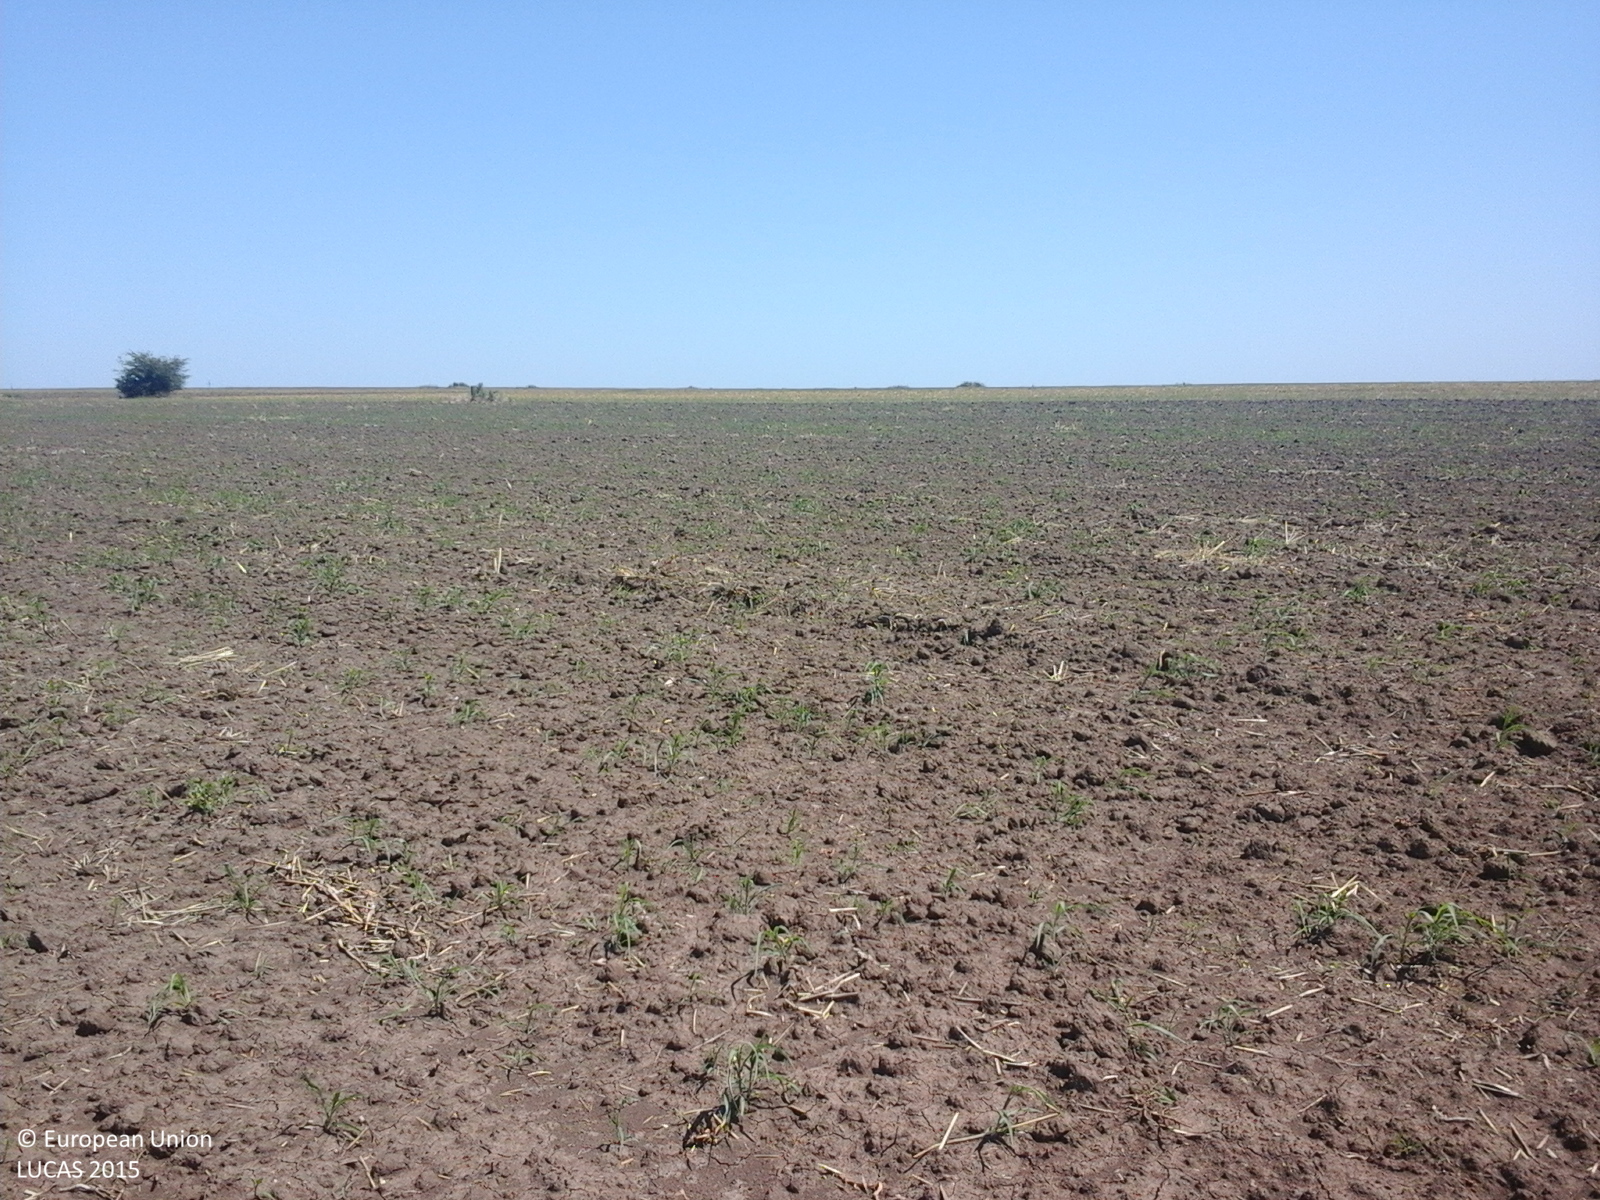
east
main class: Cropland
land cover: Common wheat
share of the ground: < 10 %
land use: Agriculture (excluding fallow land and kitchen gardens)
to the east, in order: Common wheat
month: August
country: RO
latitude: 44.2364
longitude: 28.5138
